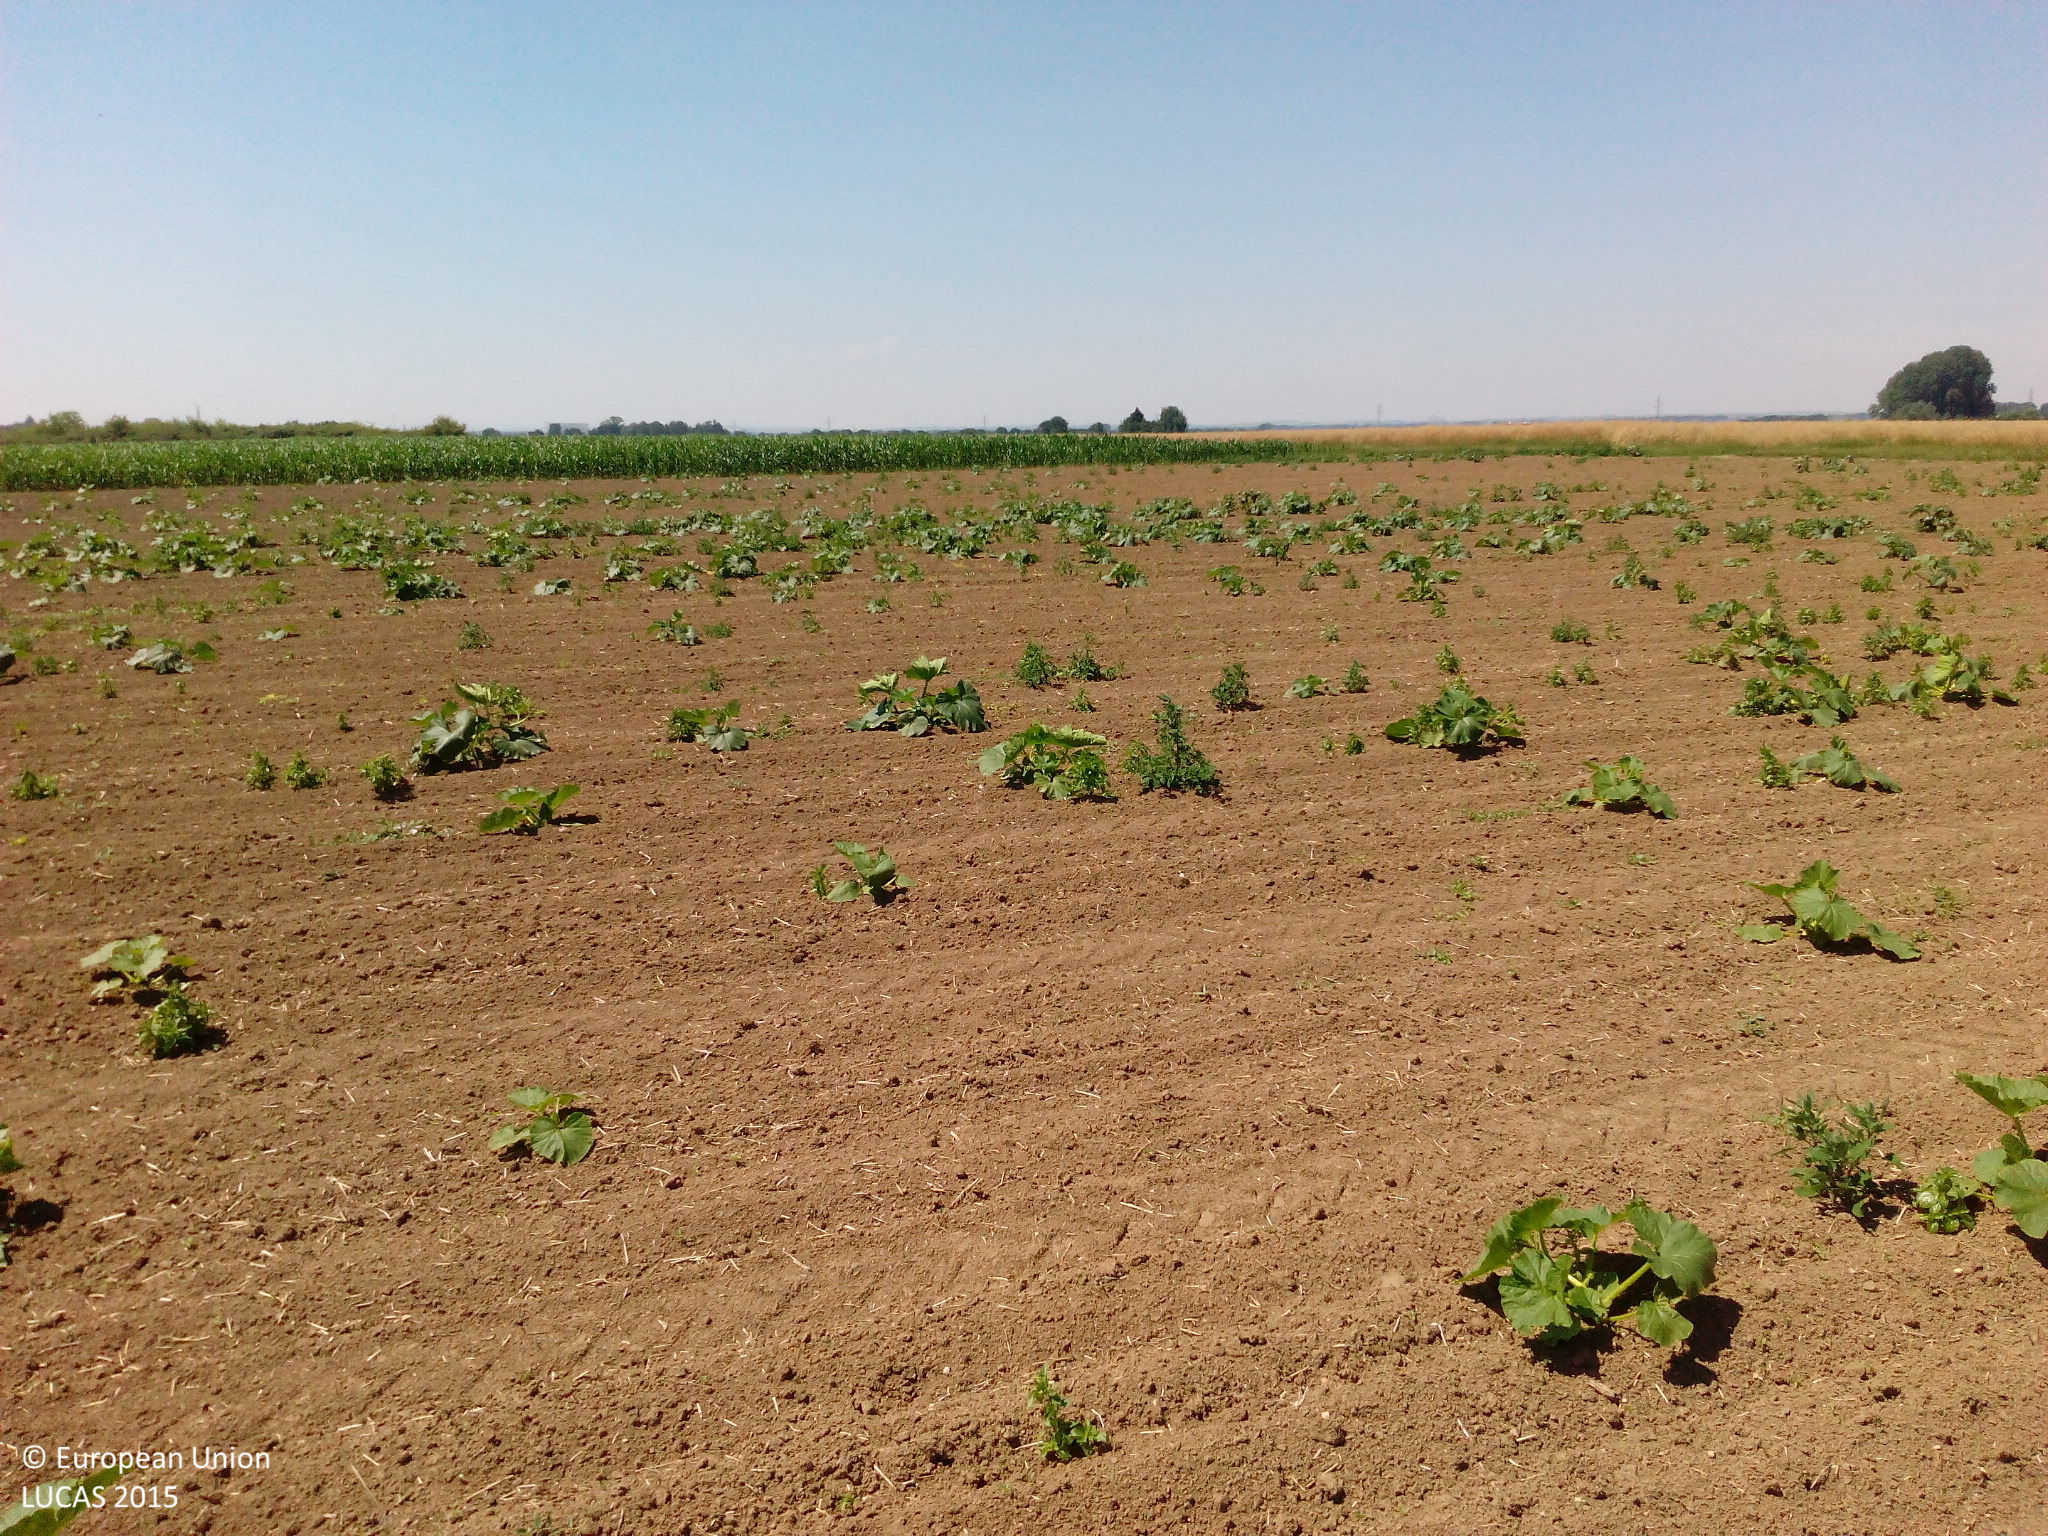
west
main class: Cropland
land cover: Other fresh vegetables
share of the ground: < 10 %
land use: Agriculture (excluding fallow land and kitchen gardens)
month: July
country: DE
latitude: 49.7972
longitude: 8.5417
